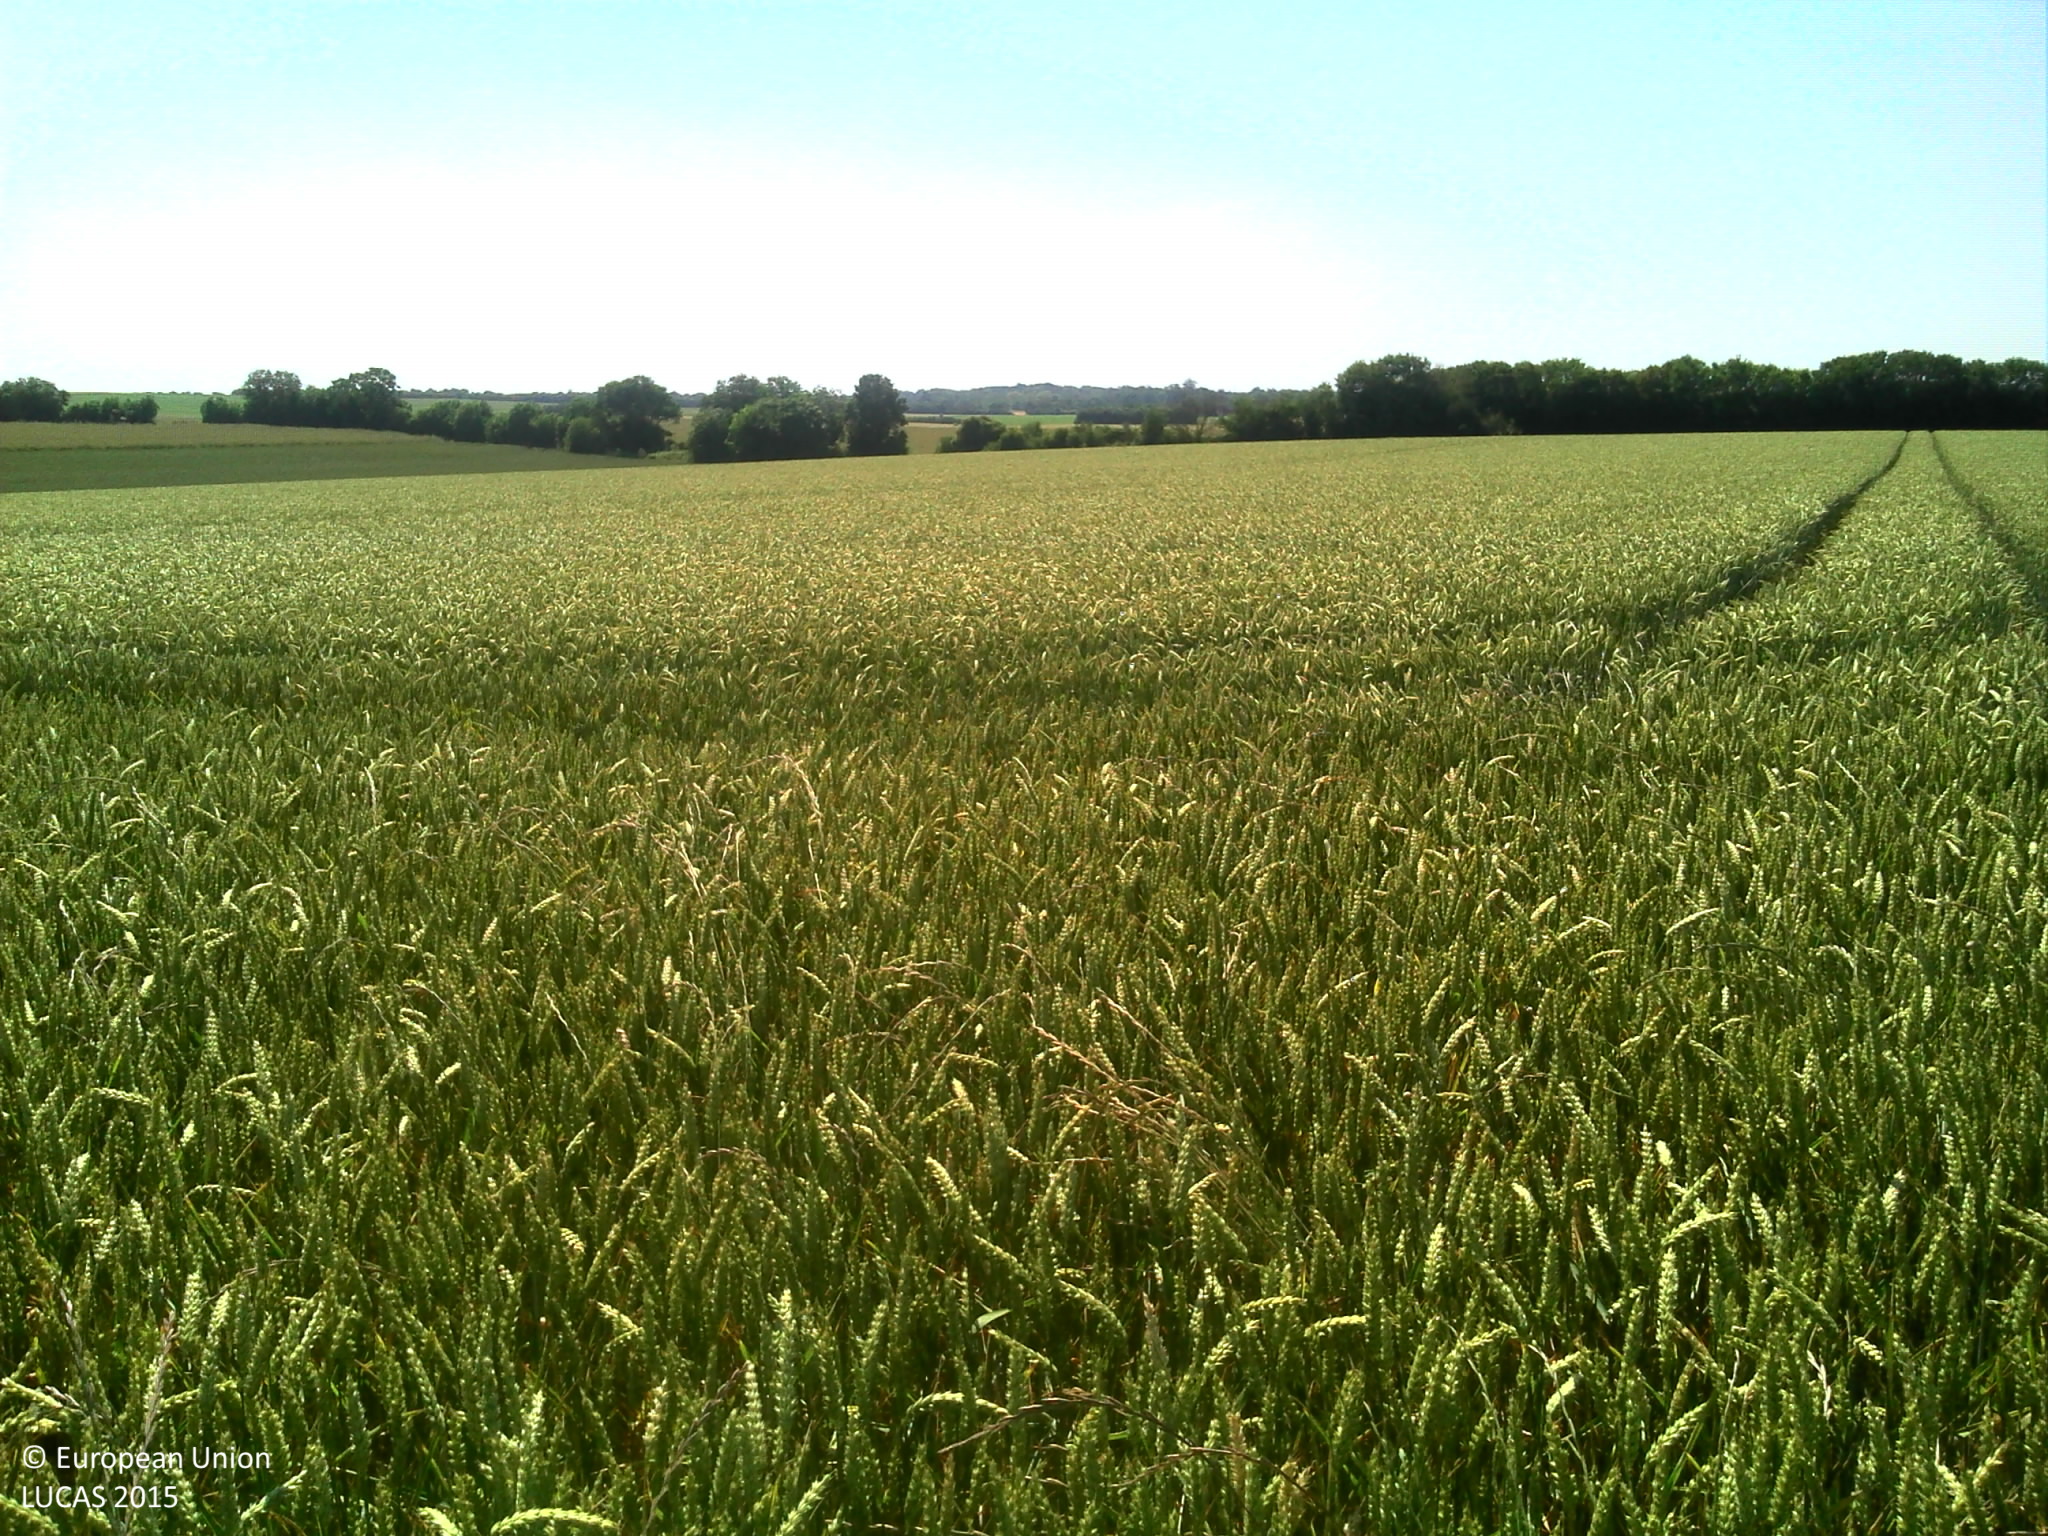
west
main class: Cropland
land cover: Common wheat
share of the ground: > 75 %
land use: Agriculture (excluding fallow land and kitchen gardens)
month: June
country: FR
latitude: 46.1077
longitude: -1.0140
